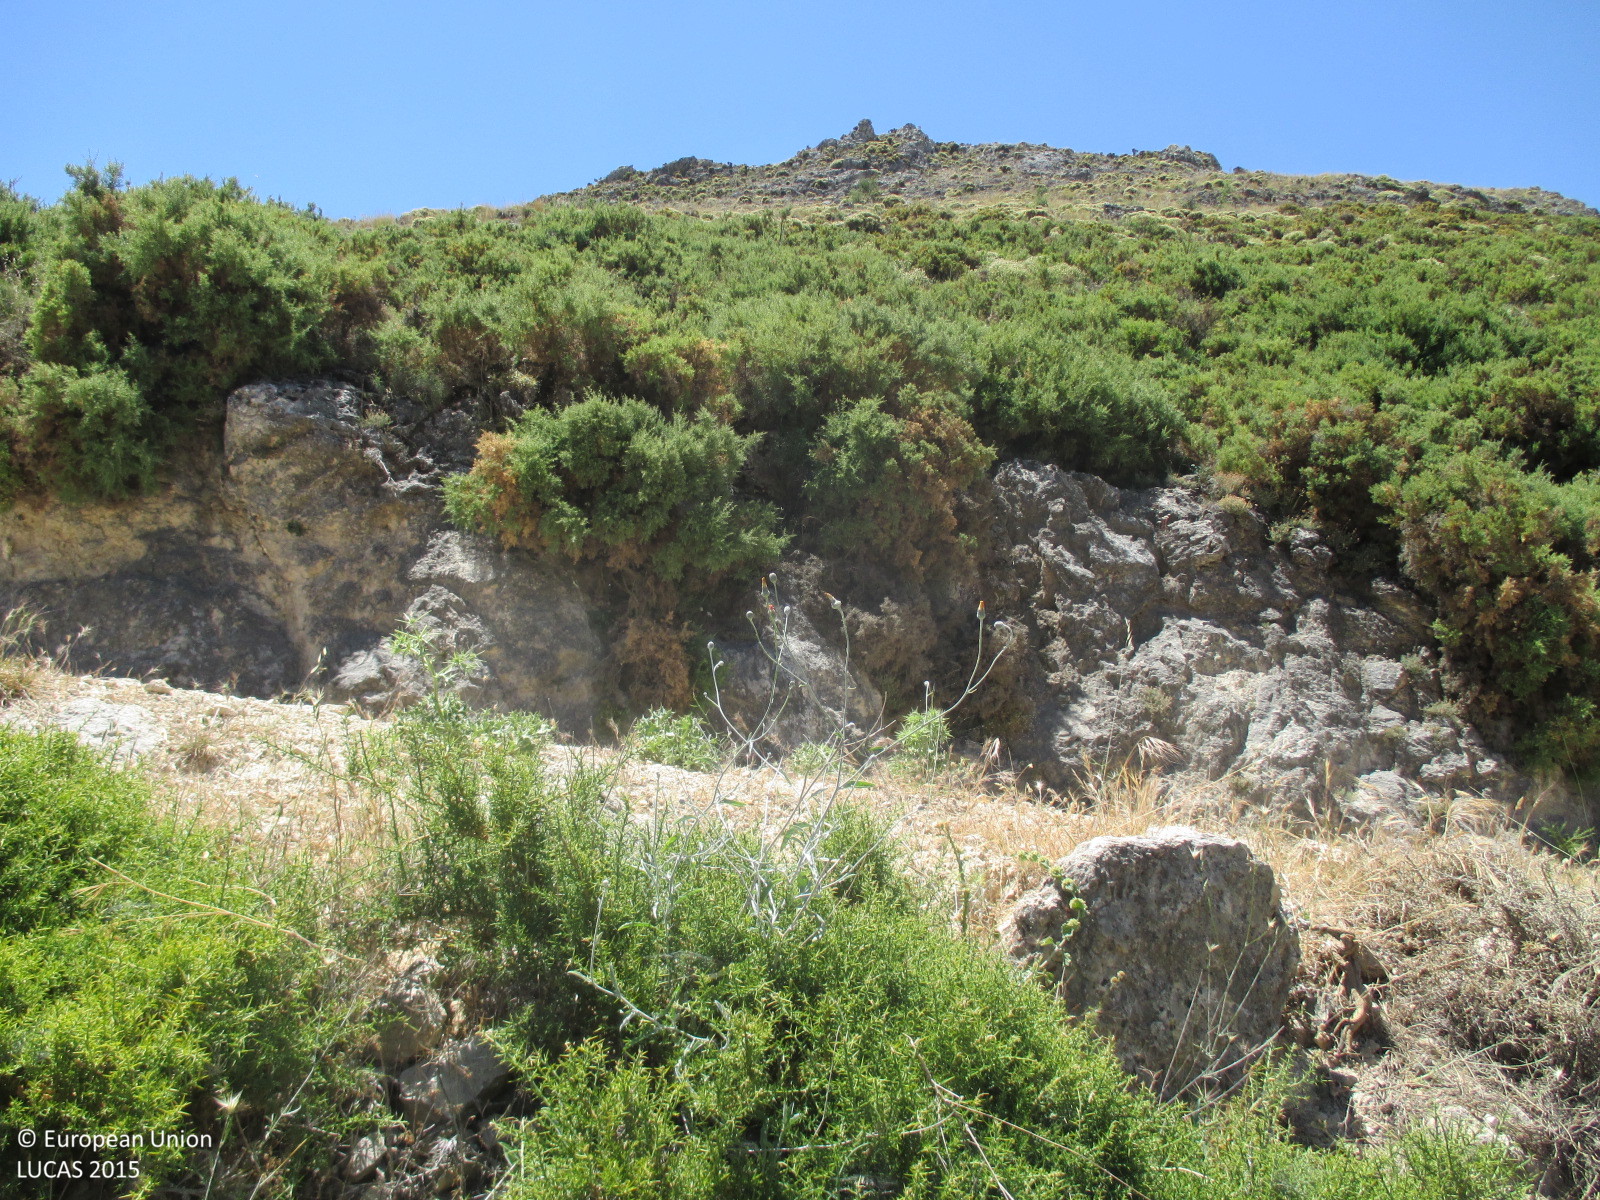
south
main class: Shrubland
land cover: Shrubland without tree cover
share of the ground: > 75 %
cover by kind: shrubs 60 %, herbaceous plants 40 %
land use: Semi-natural and natural areas not in use
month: June
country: ES
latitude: 37.4949
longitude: -3.7611
